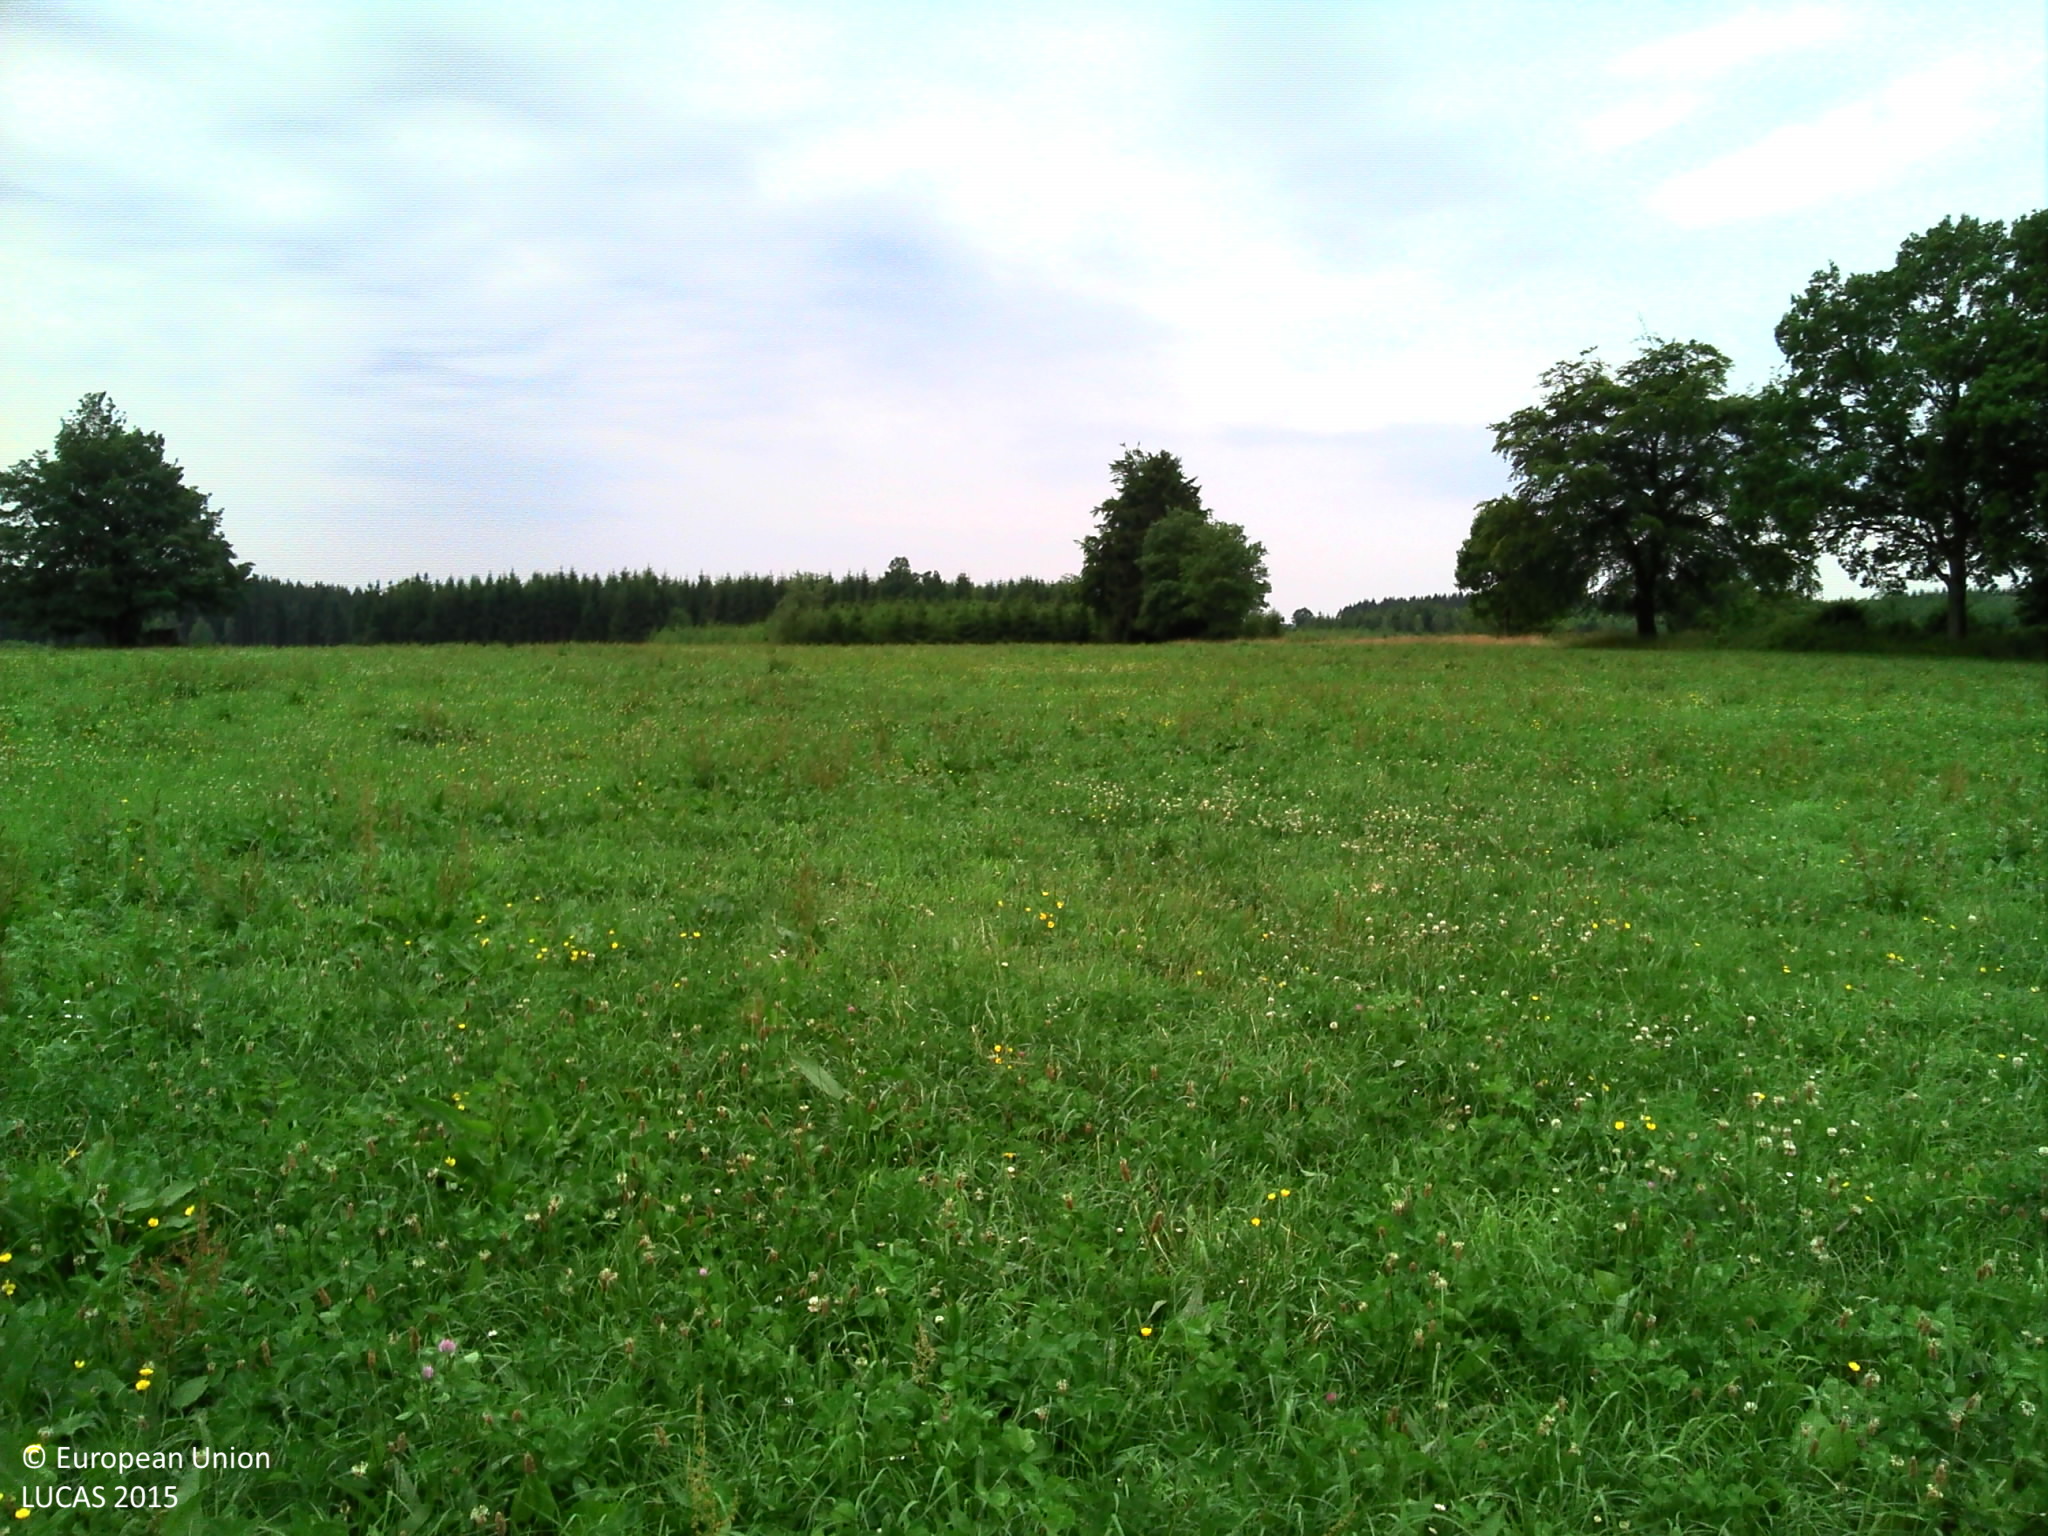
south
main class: Grassland
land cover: Grassland without tree/shrub cover
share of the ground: > 75 %
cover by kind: herbaceous plants 100 %
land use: Agriculture (excluding fallow land and kitchen gardens)
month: July
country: BE
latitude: 50.2532
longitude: 5.8614
